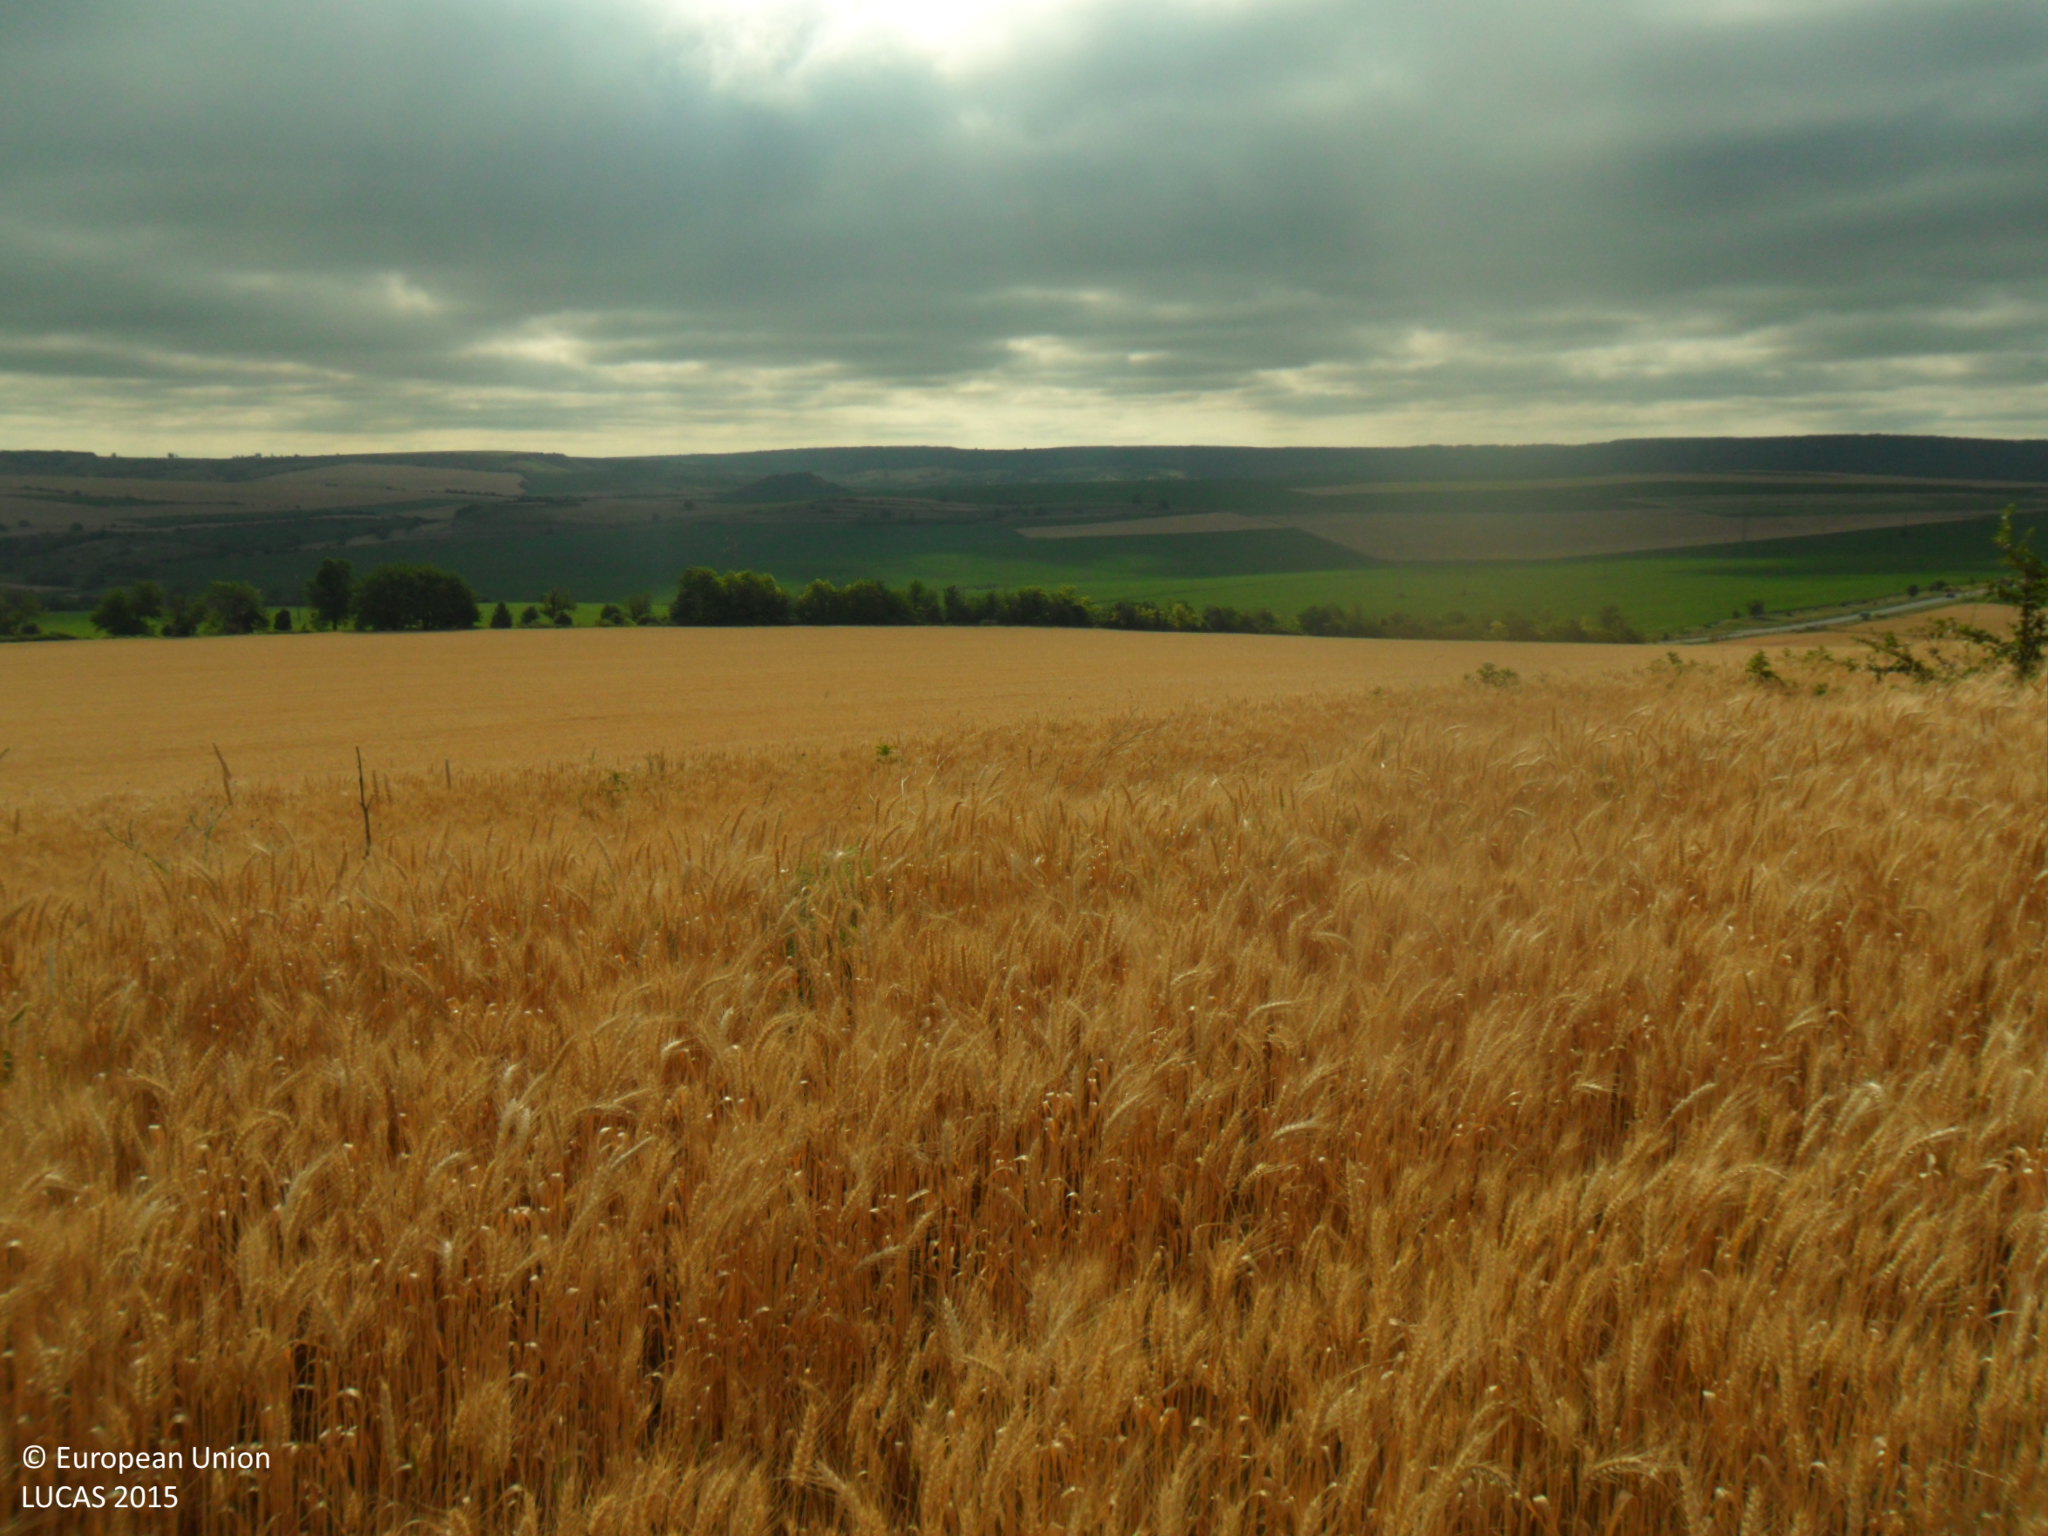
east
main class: Cropland
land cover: Common wheat
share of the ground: > 75 %
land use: Agriculture (excluding fallow land and kitchen gardens)
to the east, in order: Common wheat; Grass margins; Common wheat; Grass margins; Common wheat
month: June
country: BG
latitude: 43.4852
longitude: 27.1216
